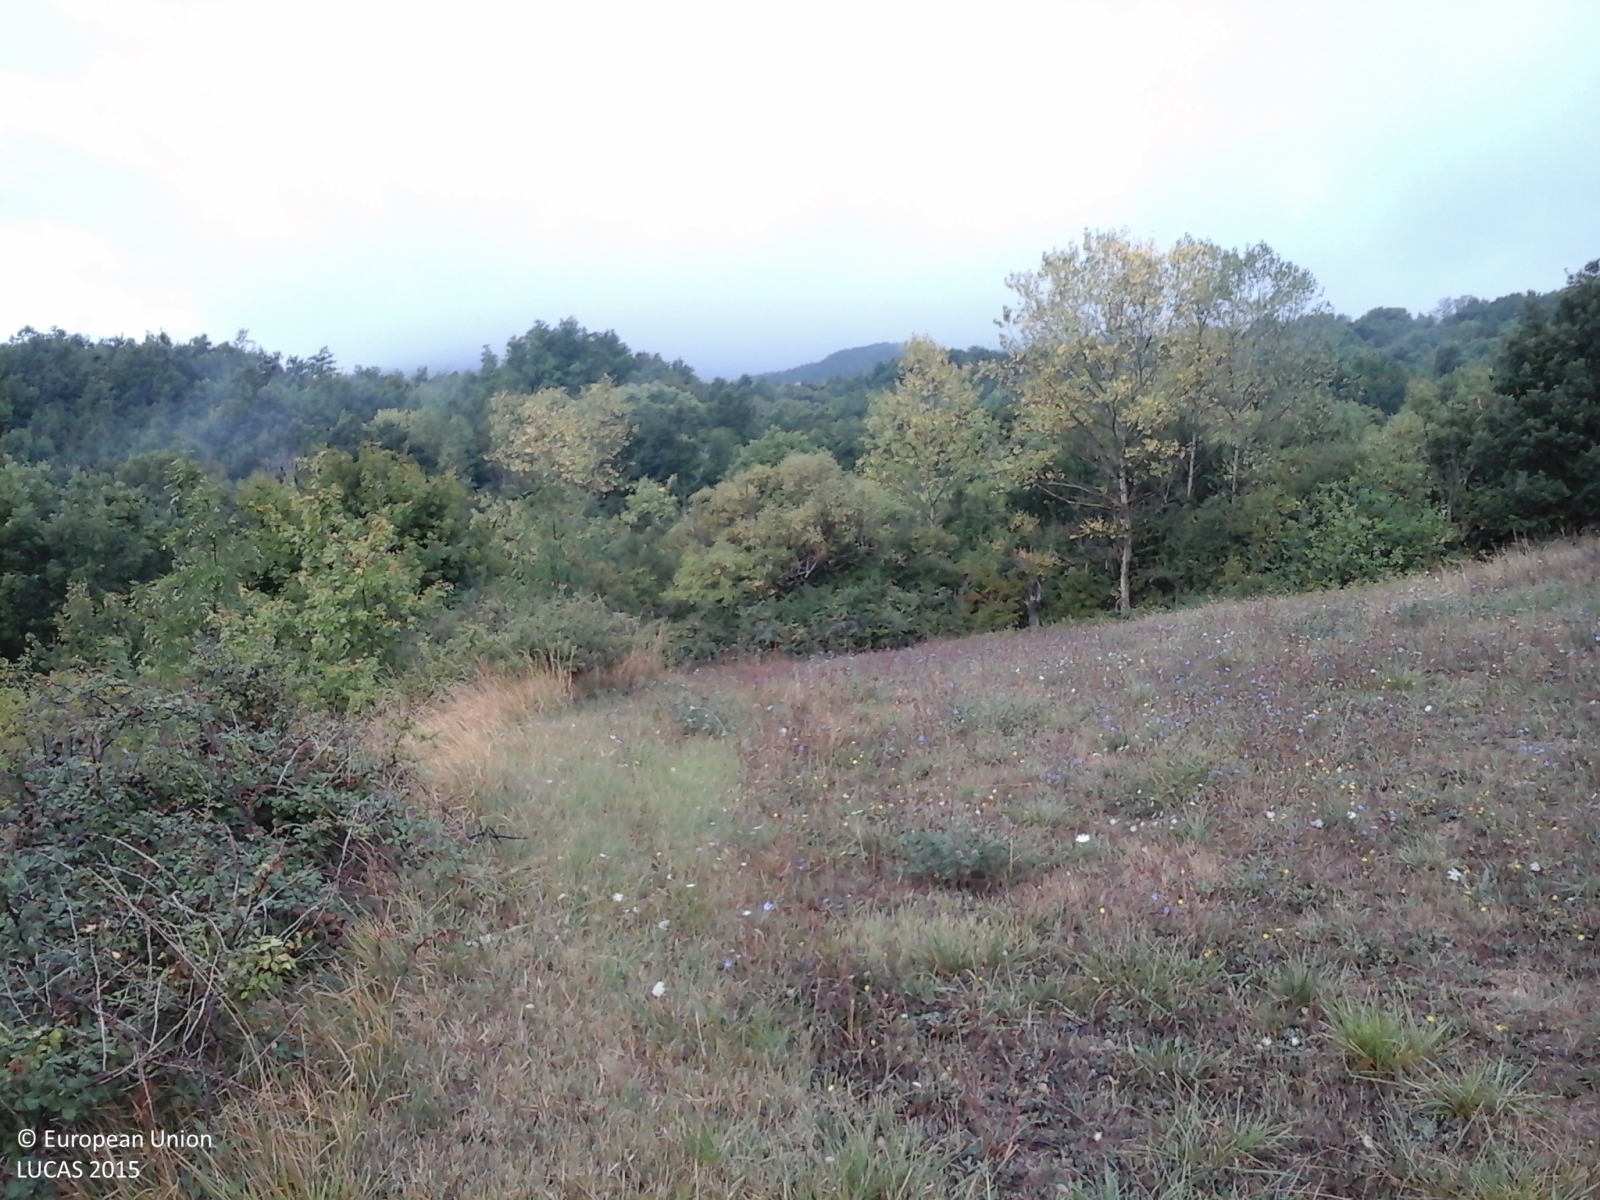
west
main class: Cropland
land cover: Temporary grasslands
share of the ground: > 75 %
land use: Agriculture (excluding fallow land and kitchen gardens)
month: September
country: IT
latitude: 41.7264
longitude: 14.3968
